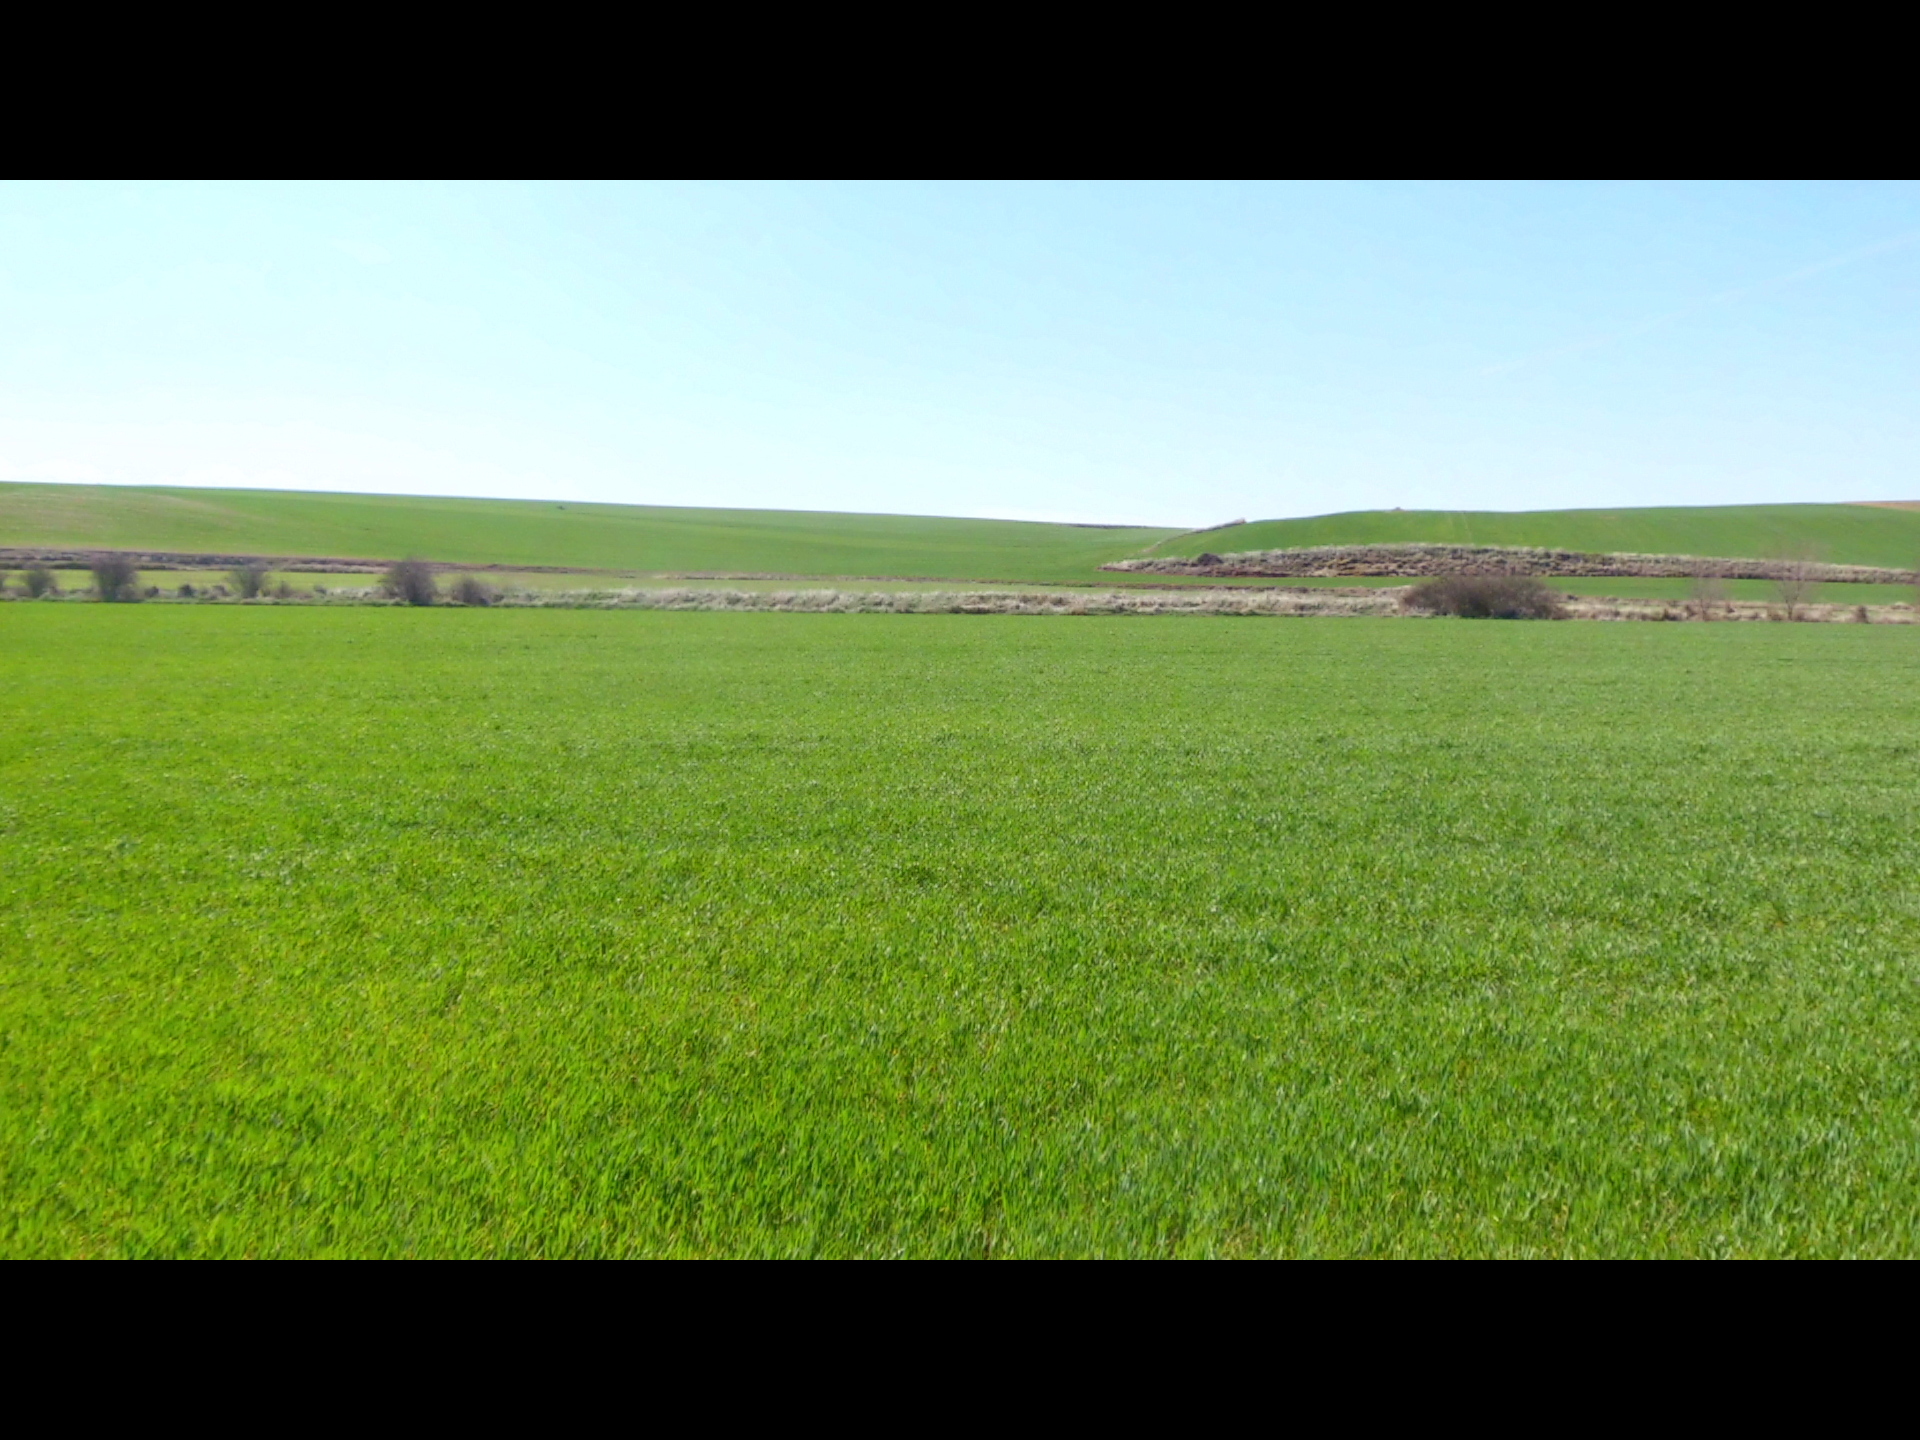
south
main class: Cropland
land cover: Barley
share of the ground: > 75 %
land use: Agriculture (excluding fallow land and kitchen gardens)
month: April
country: ES
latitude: 42.1765
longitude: -3.8255
